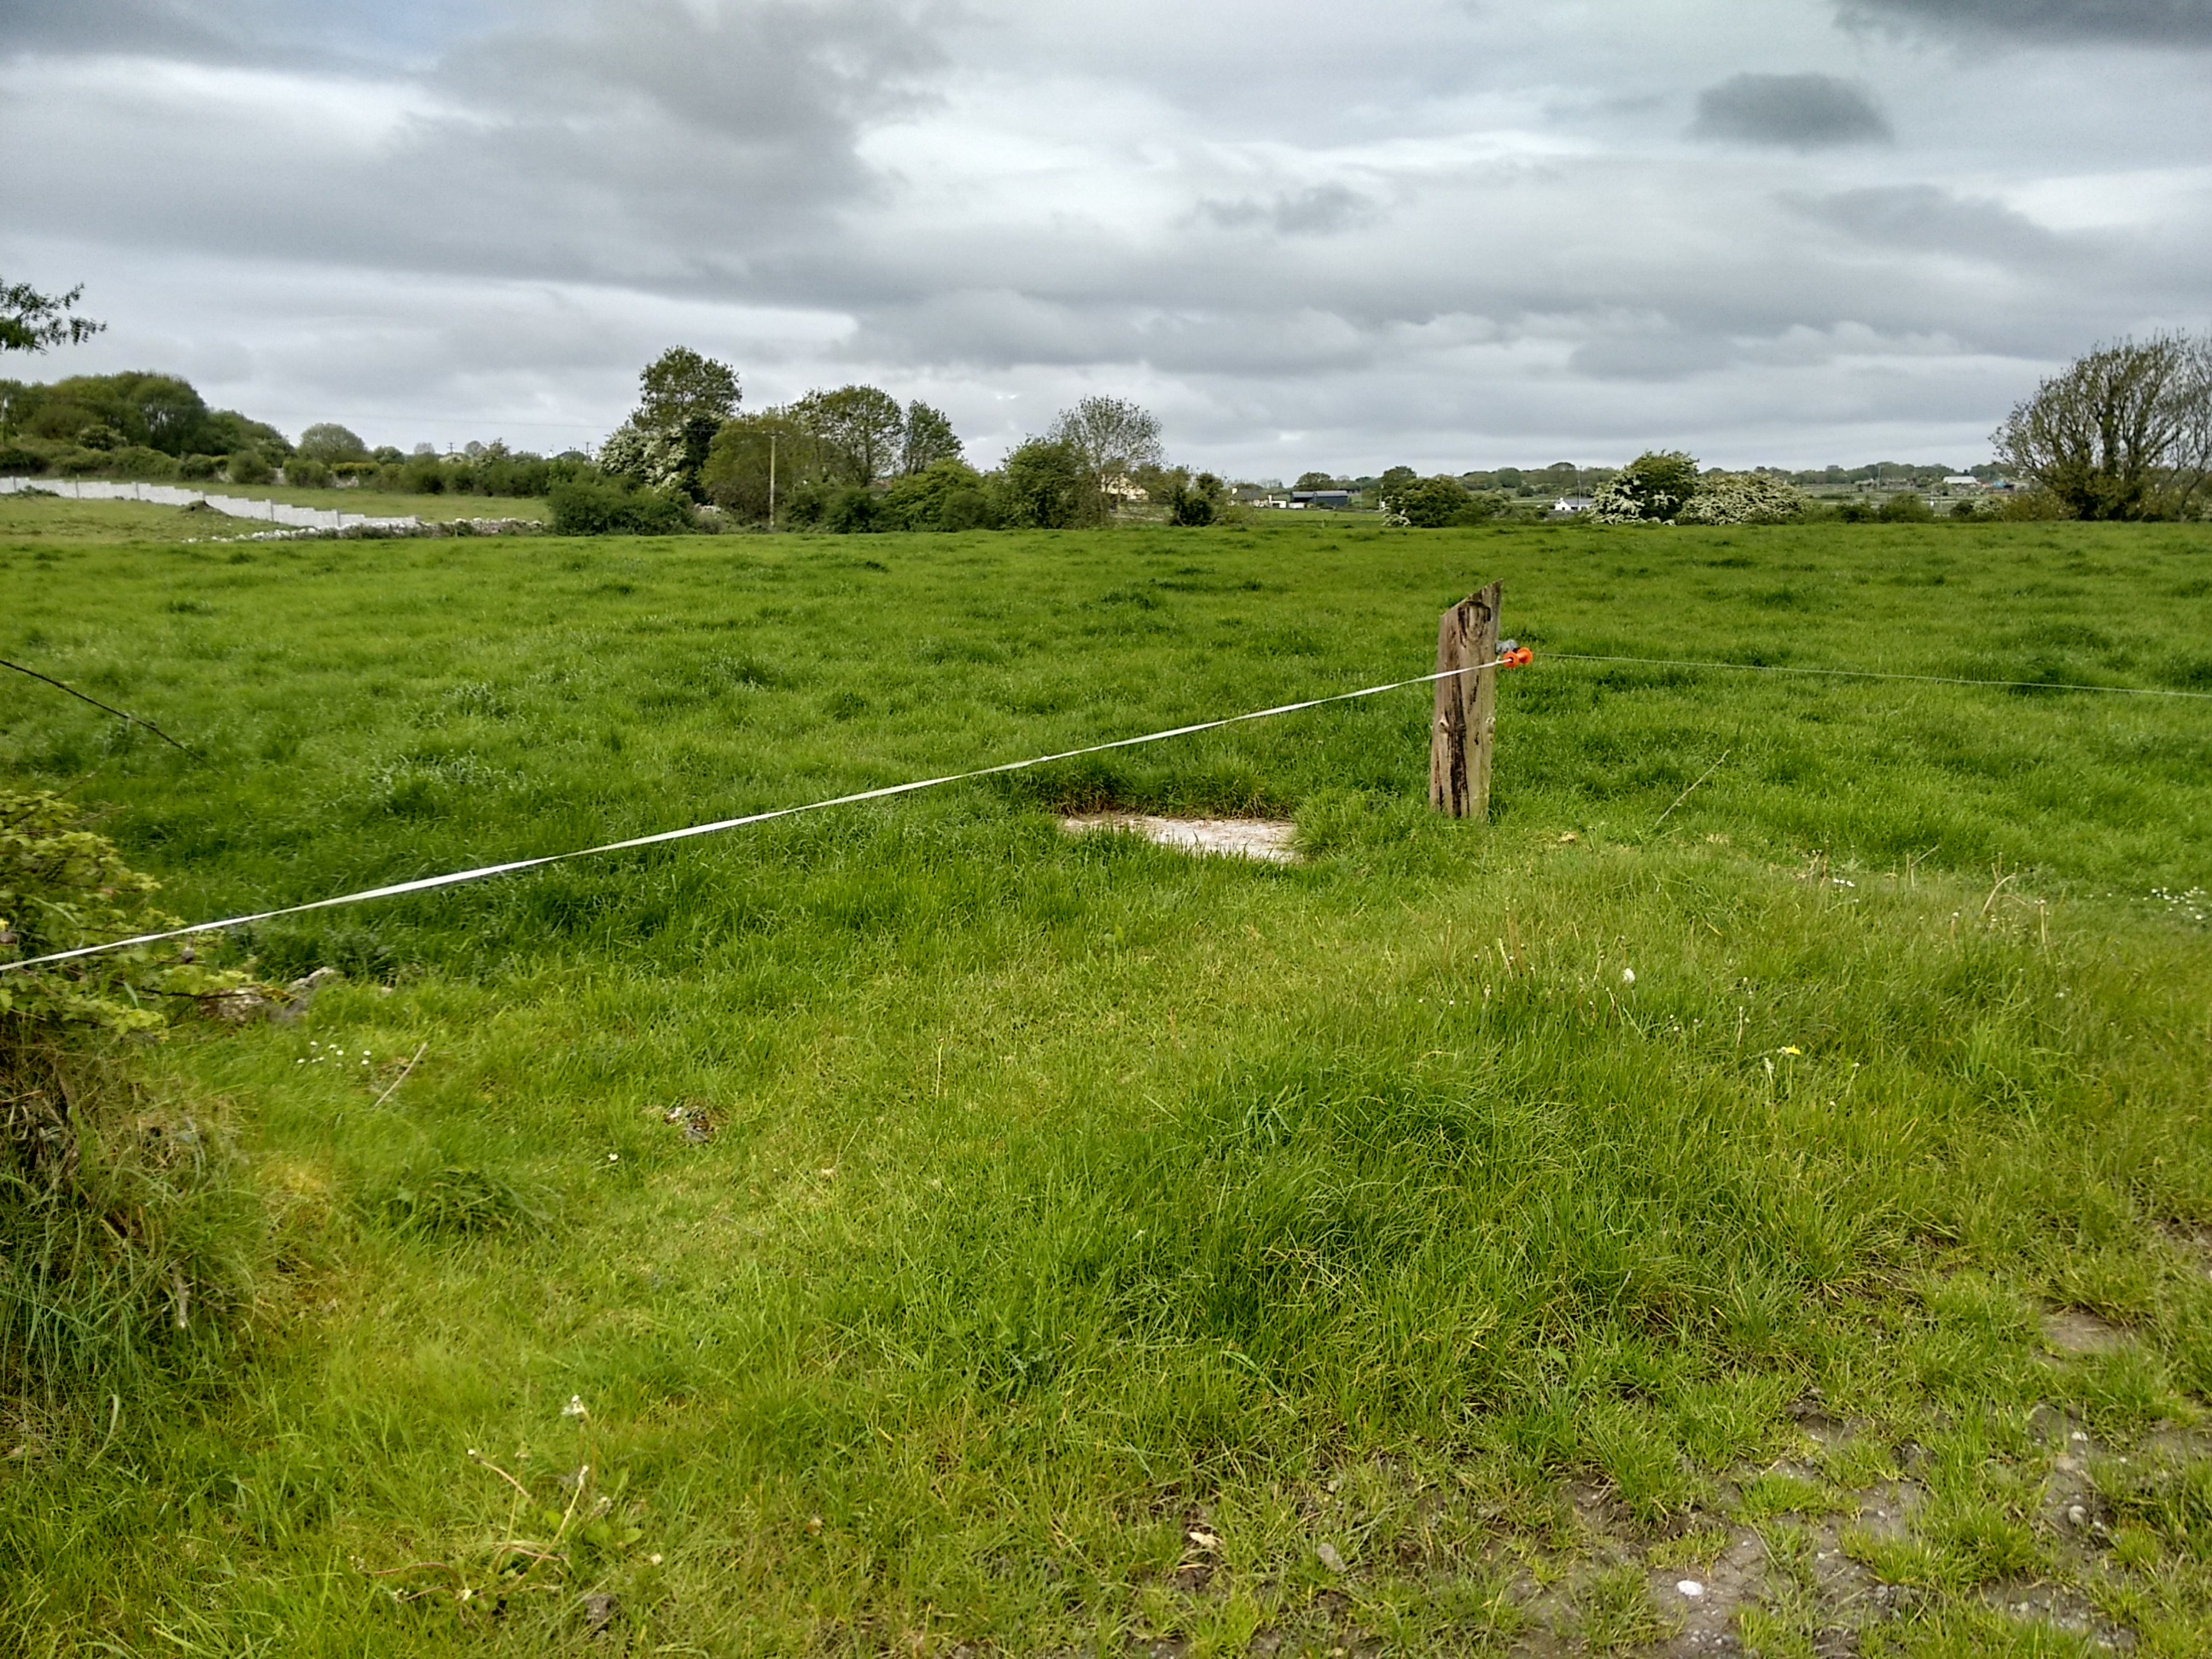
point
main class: Grassland
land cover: Grassland without tree/shrub cover
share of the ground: > 75 %
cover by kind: herbaceous plants 100 %
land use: Agriculture (excluding fallow land and kitchen gardens)
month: May
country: IE
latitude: 53.3307
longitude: -8.9345
